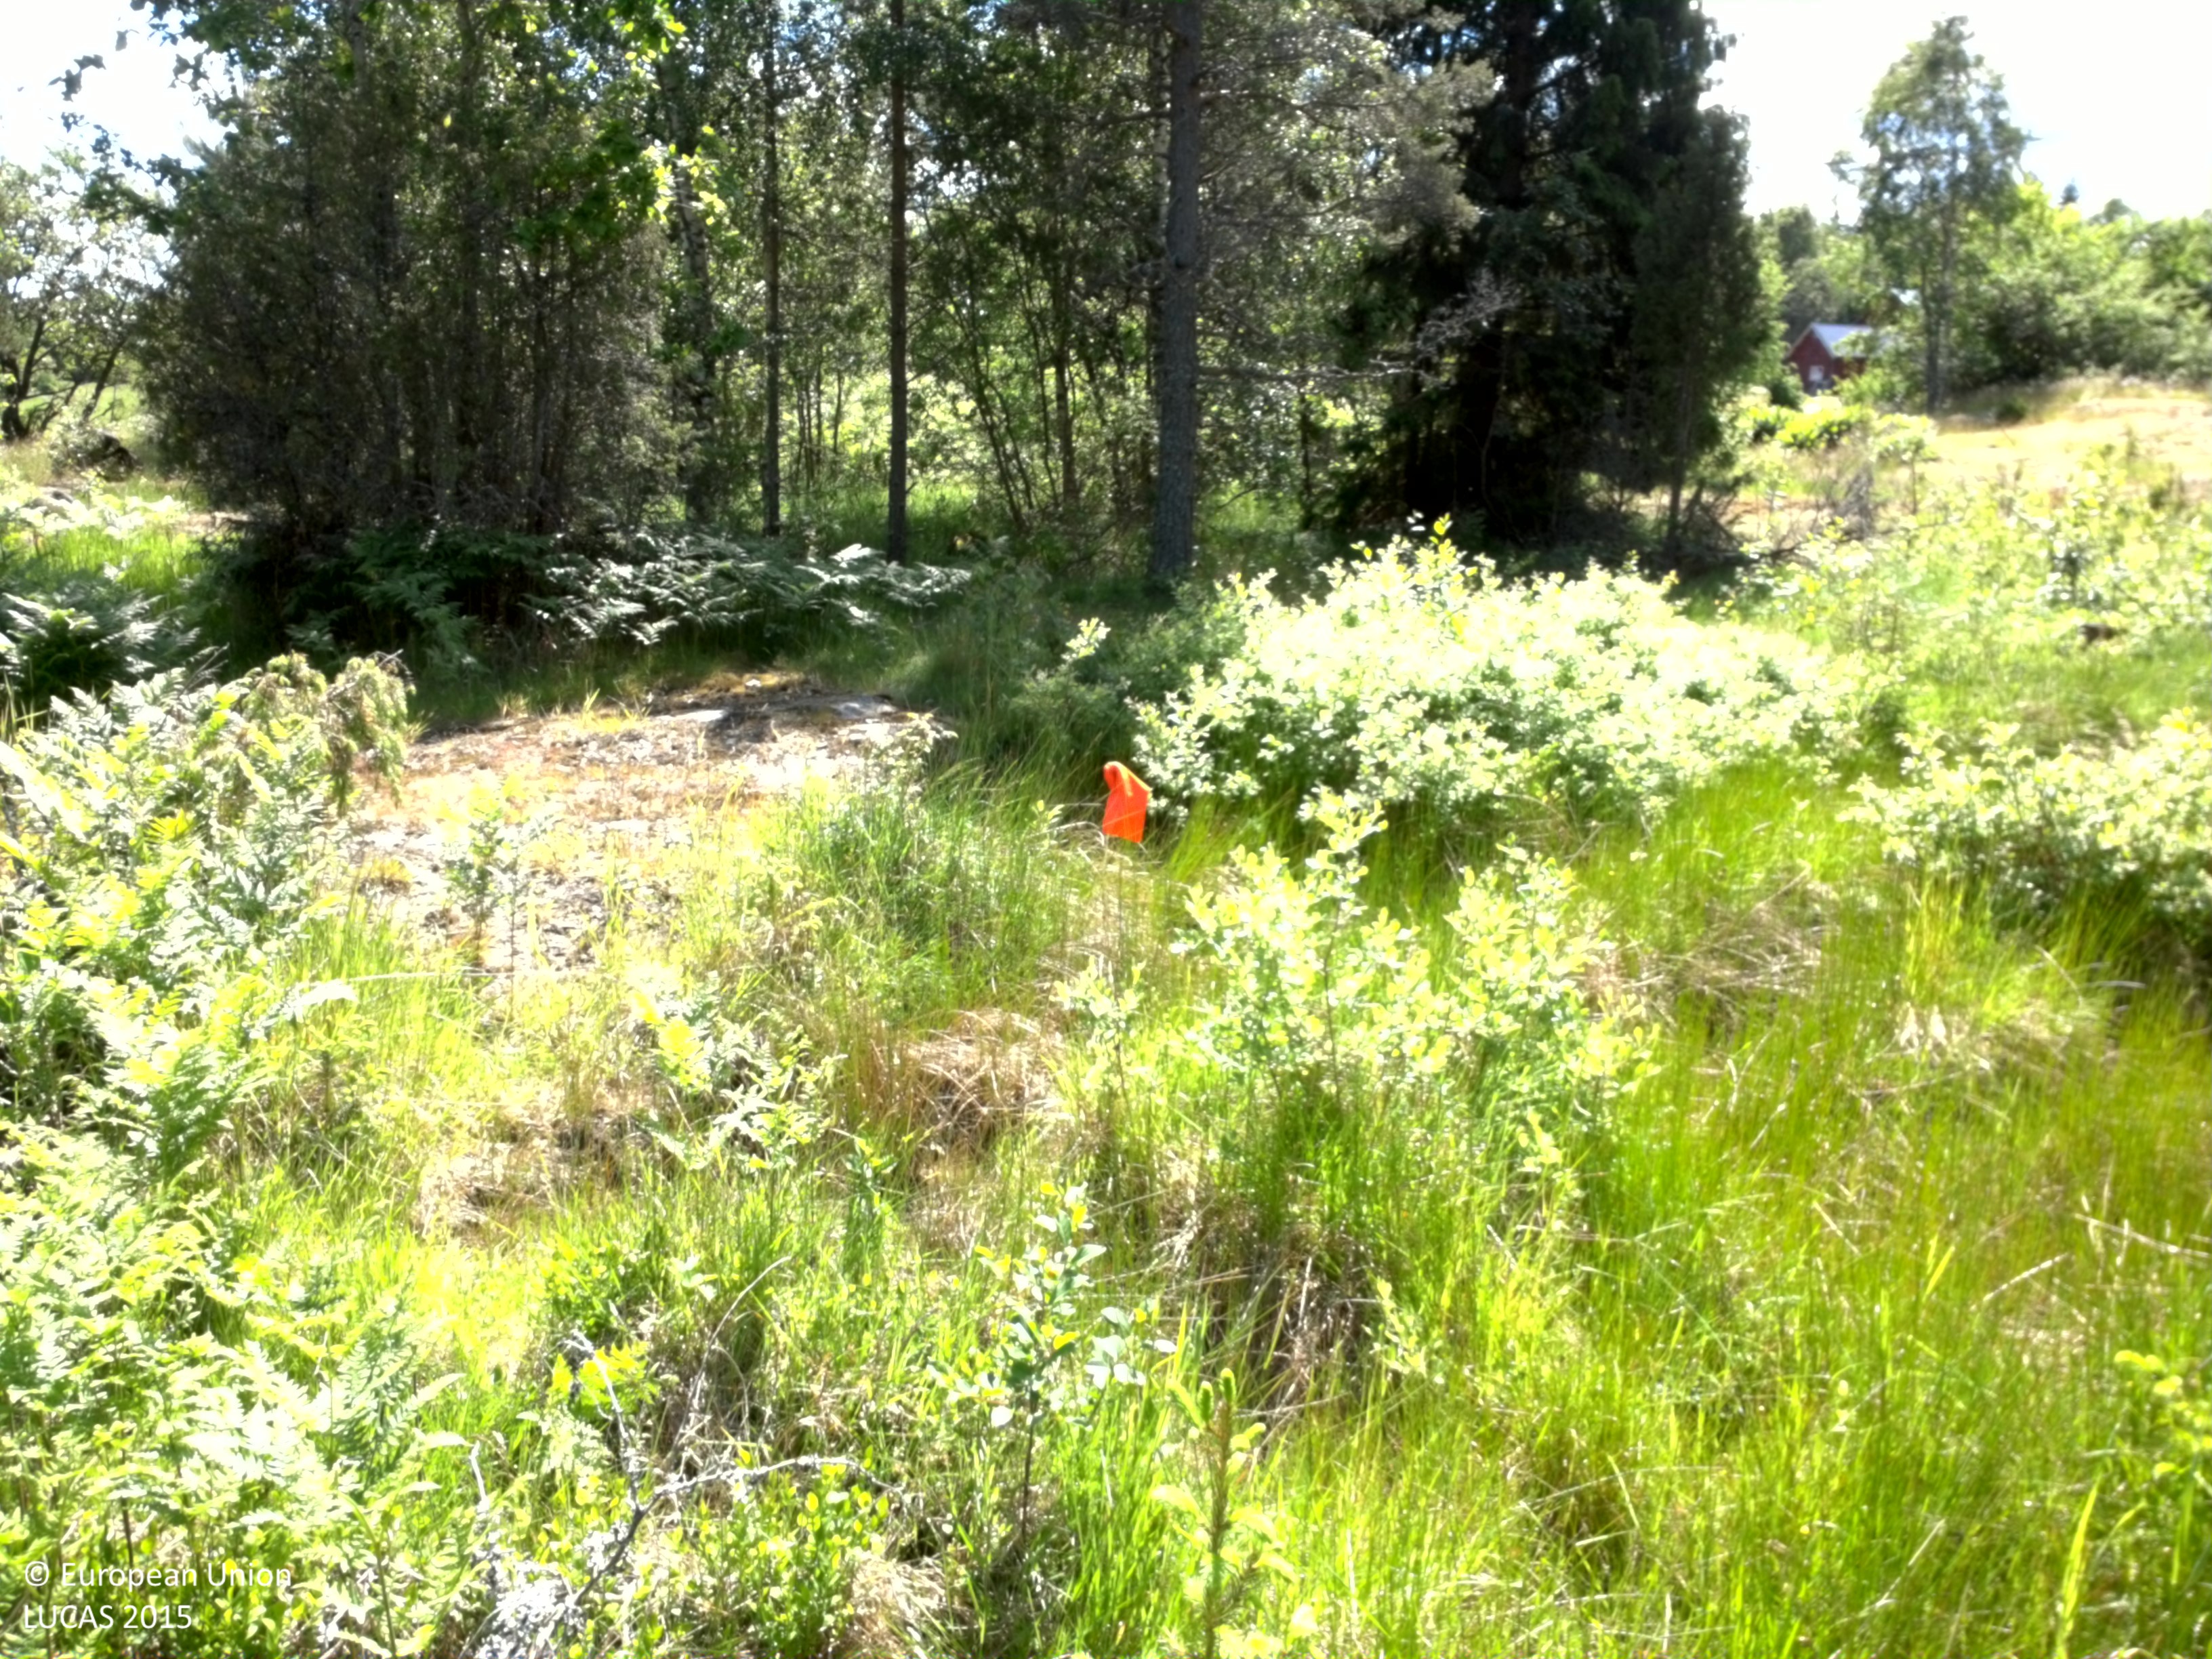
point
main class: Woodland
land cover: Other mixed woodland
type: boreal forest
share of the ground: 25 - 50 %
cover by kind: herbaceous plants 55 %, broadleaved forest trees 20 %, coniferous forest trees 15 %, shrubs 10 %
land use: Forestry
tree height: < 5 m
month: June
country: SE
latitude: 58.4273
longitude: 16.4175
